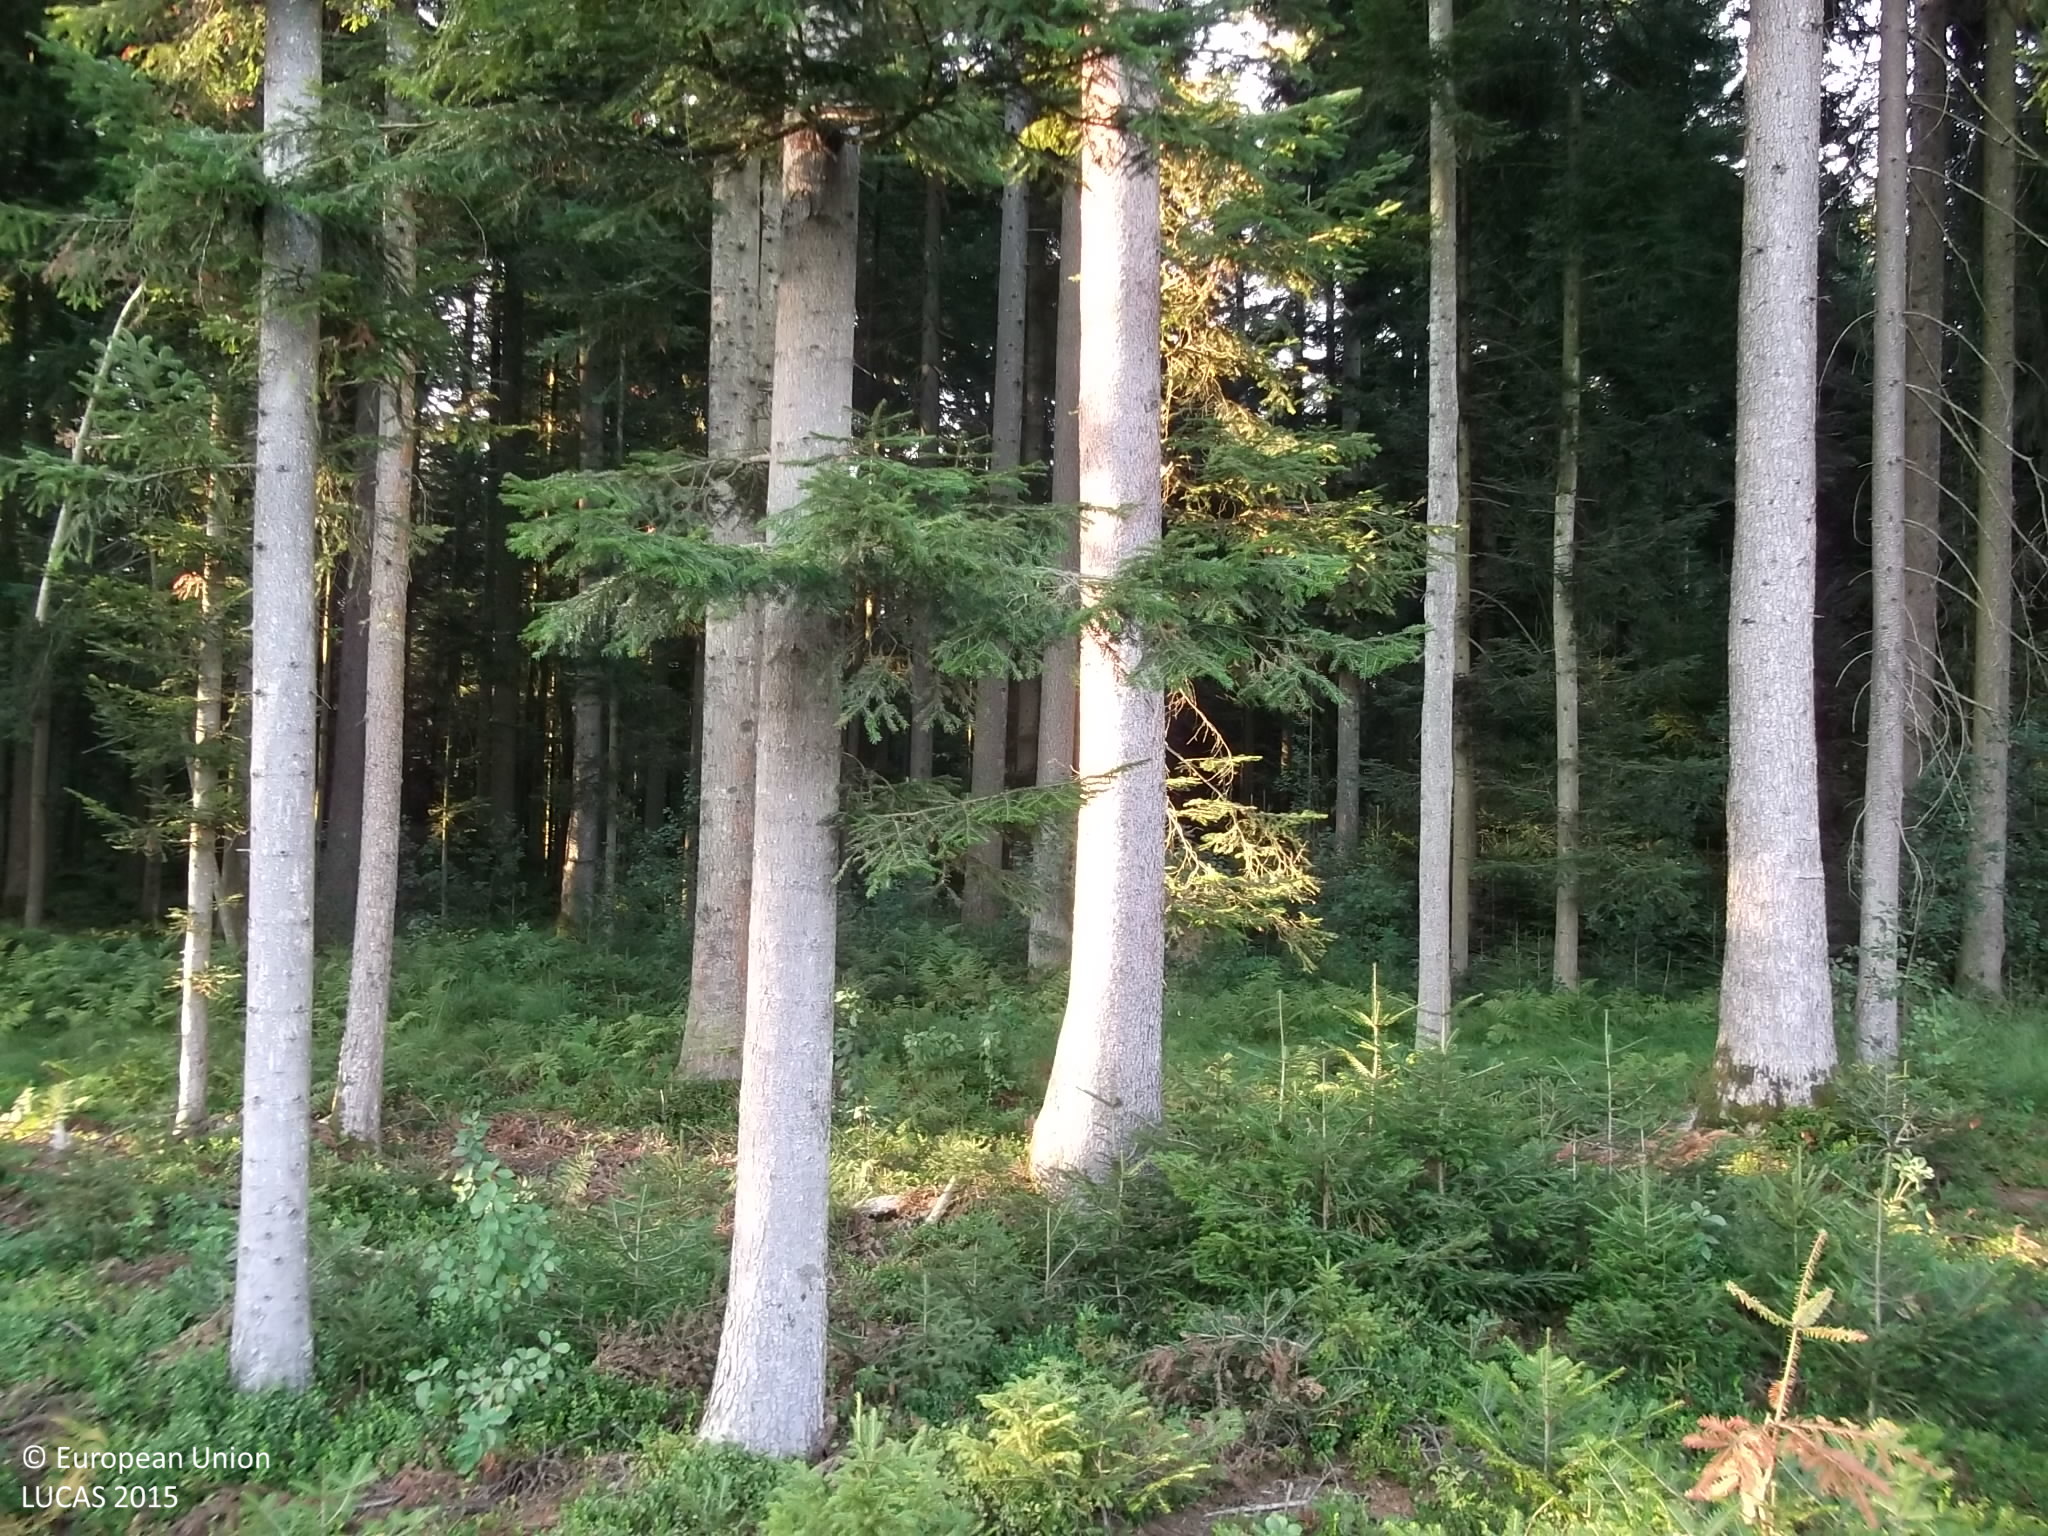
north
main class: Woodland
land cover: Spruce dominated mixed woodland
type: hemiboreal forest and nemoral coniferous forest and mixed broadleaved-coniferous forest
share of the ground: > 75 %
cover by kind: broadleaved forest trees 35 %, coniferous forest trees 30 %, shrubs 20 %, herbaceous plants 15 %
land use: Forestry
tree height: < 5 m
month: August
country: AT
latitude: 47.9700
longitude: 13.4951
